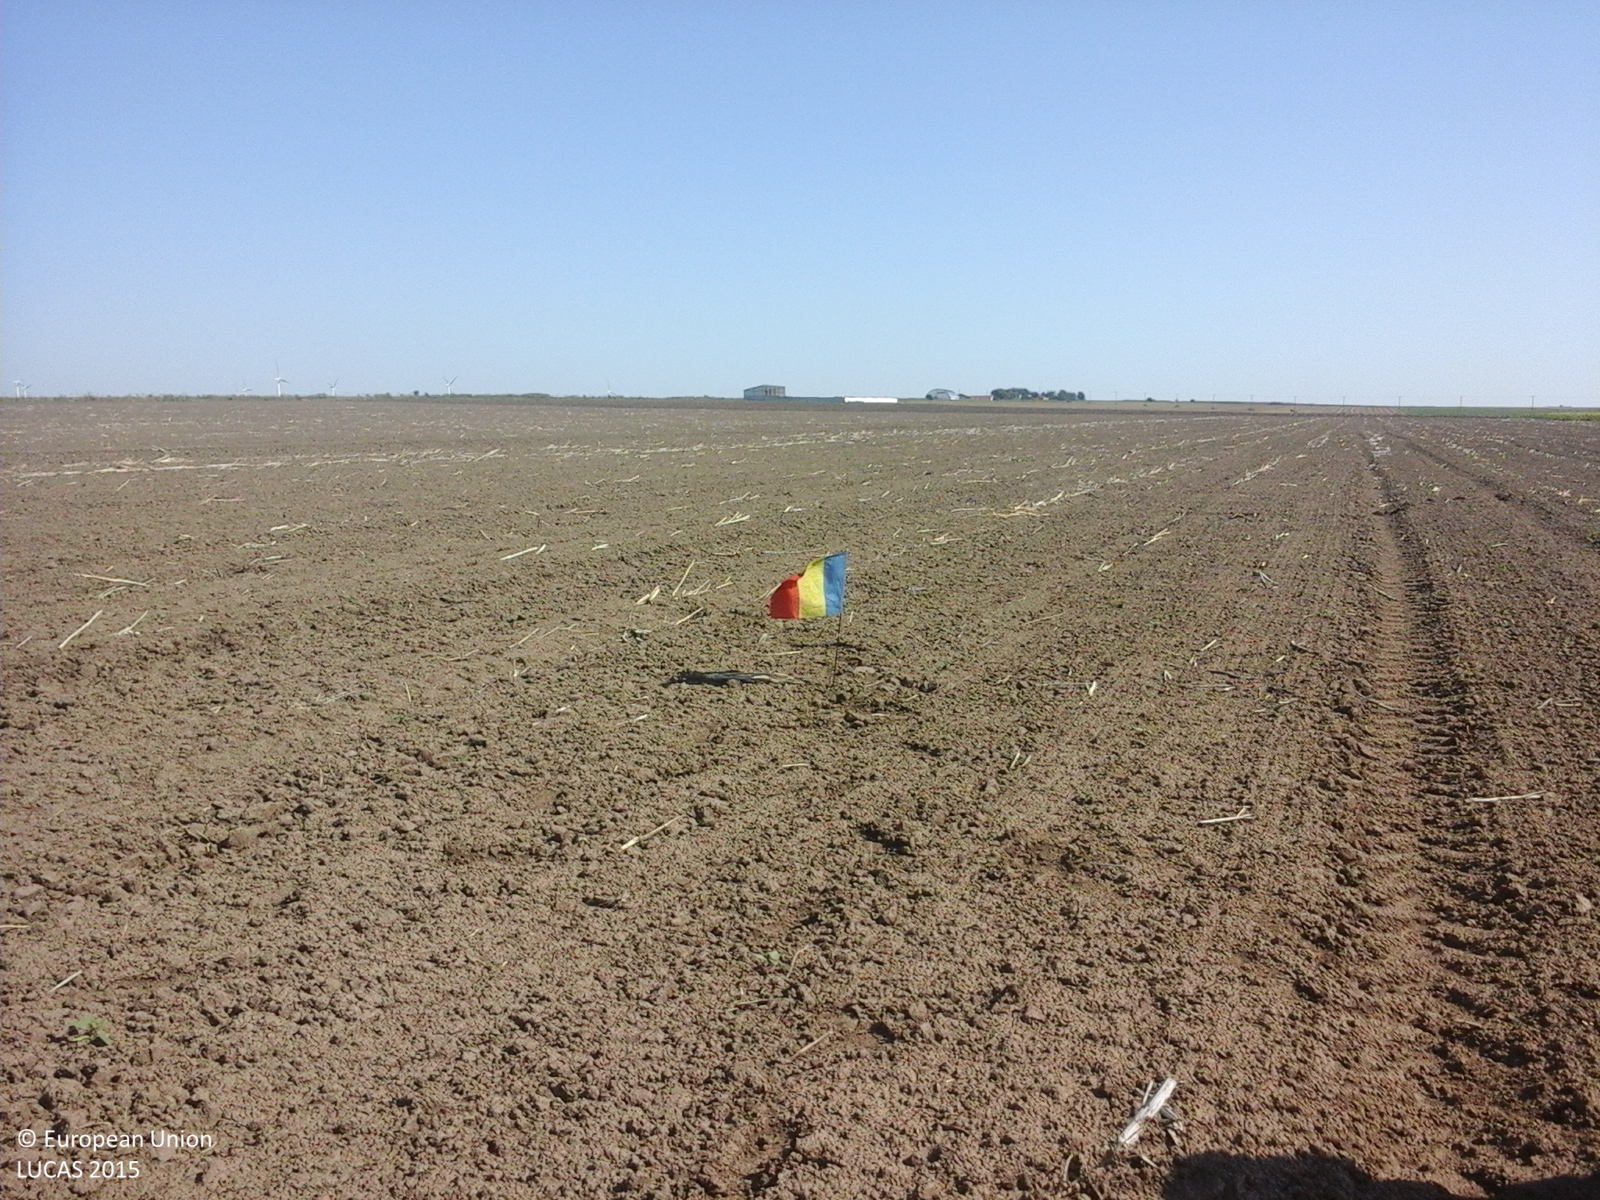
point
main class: Cropland
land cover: Rape and turnip rape
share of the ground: < 10 %
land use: Agriculture (excluding fallow land and kitchen gardens)
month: August
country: RO
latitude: 44.3151
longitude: 28.3846
